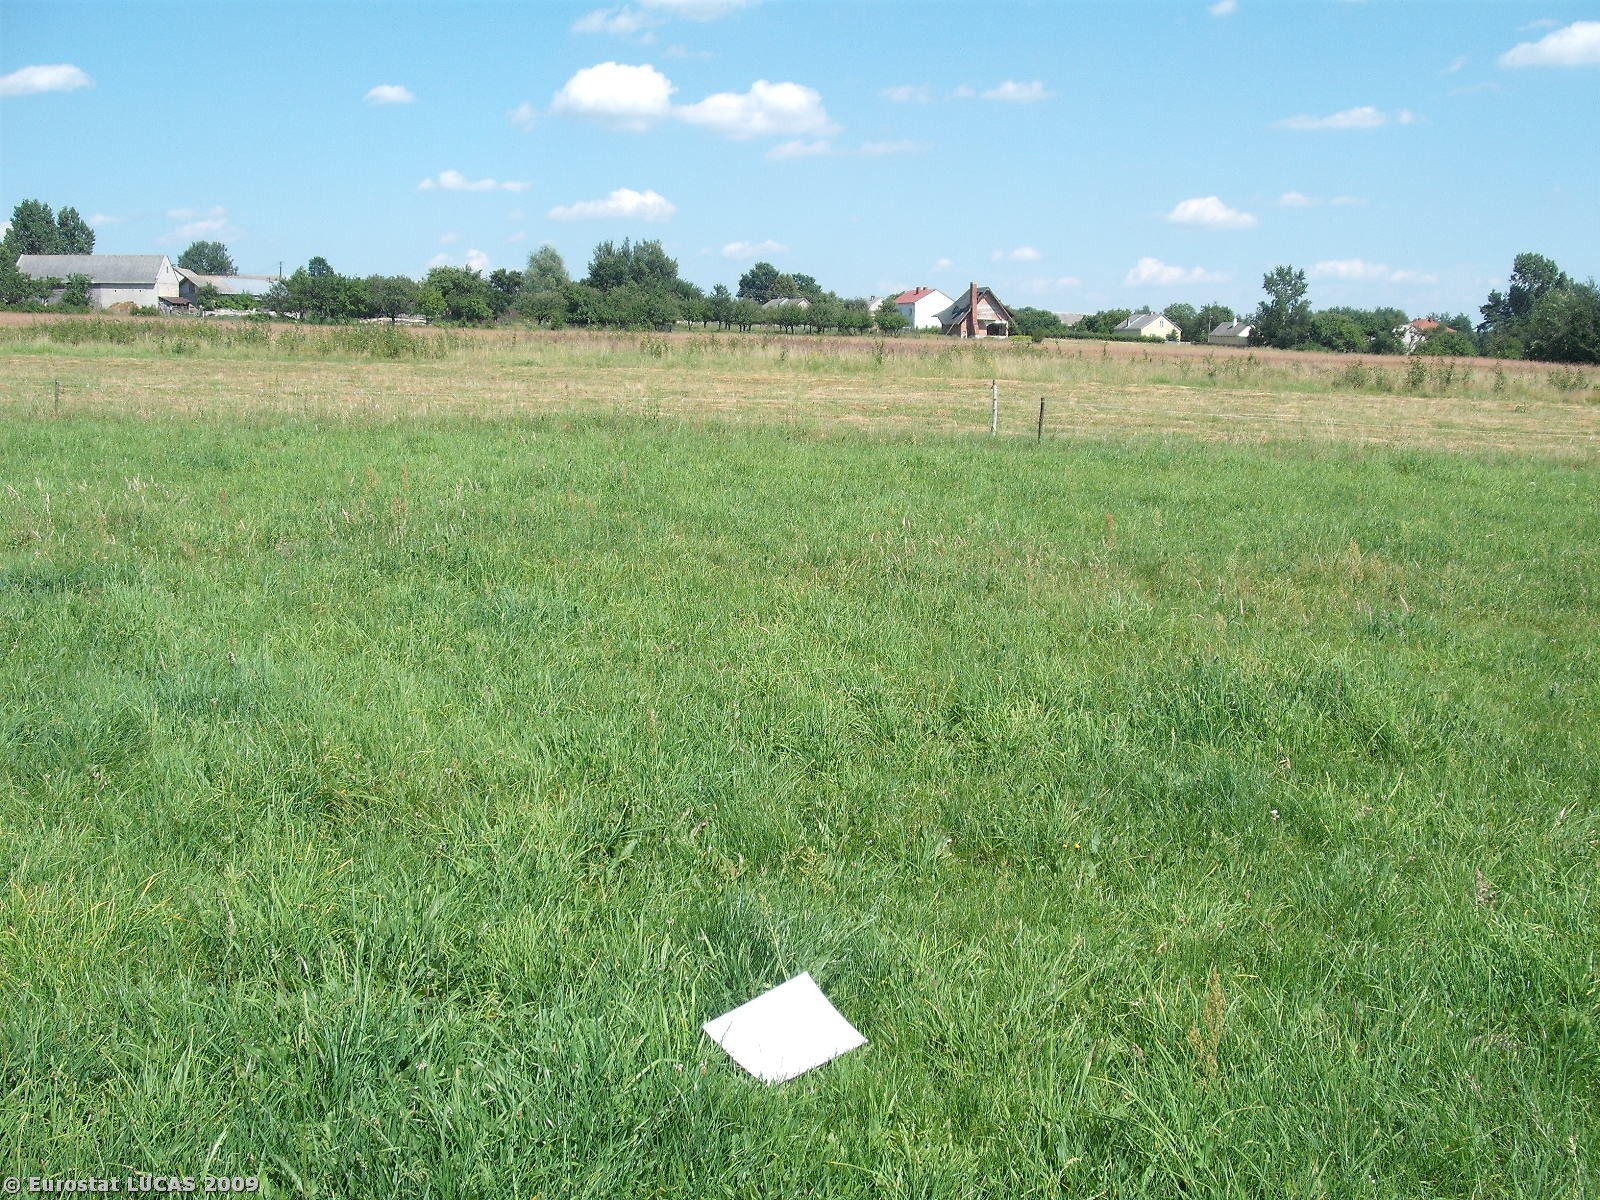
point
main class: Grassland
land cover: Grassland without tree/shrub cover
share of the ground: > 75 %
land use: Agriculture (excluding fallow land and kitchen gardens)
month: July
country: PL
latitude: 50.6747
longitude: 20.7246
